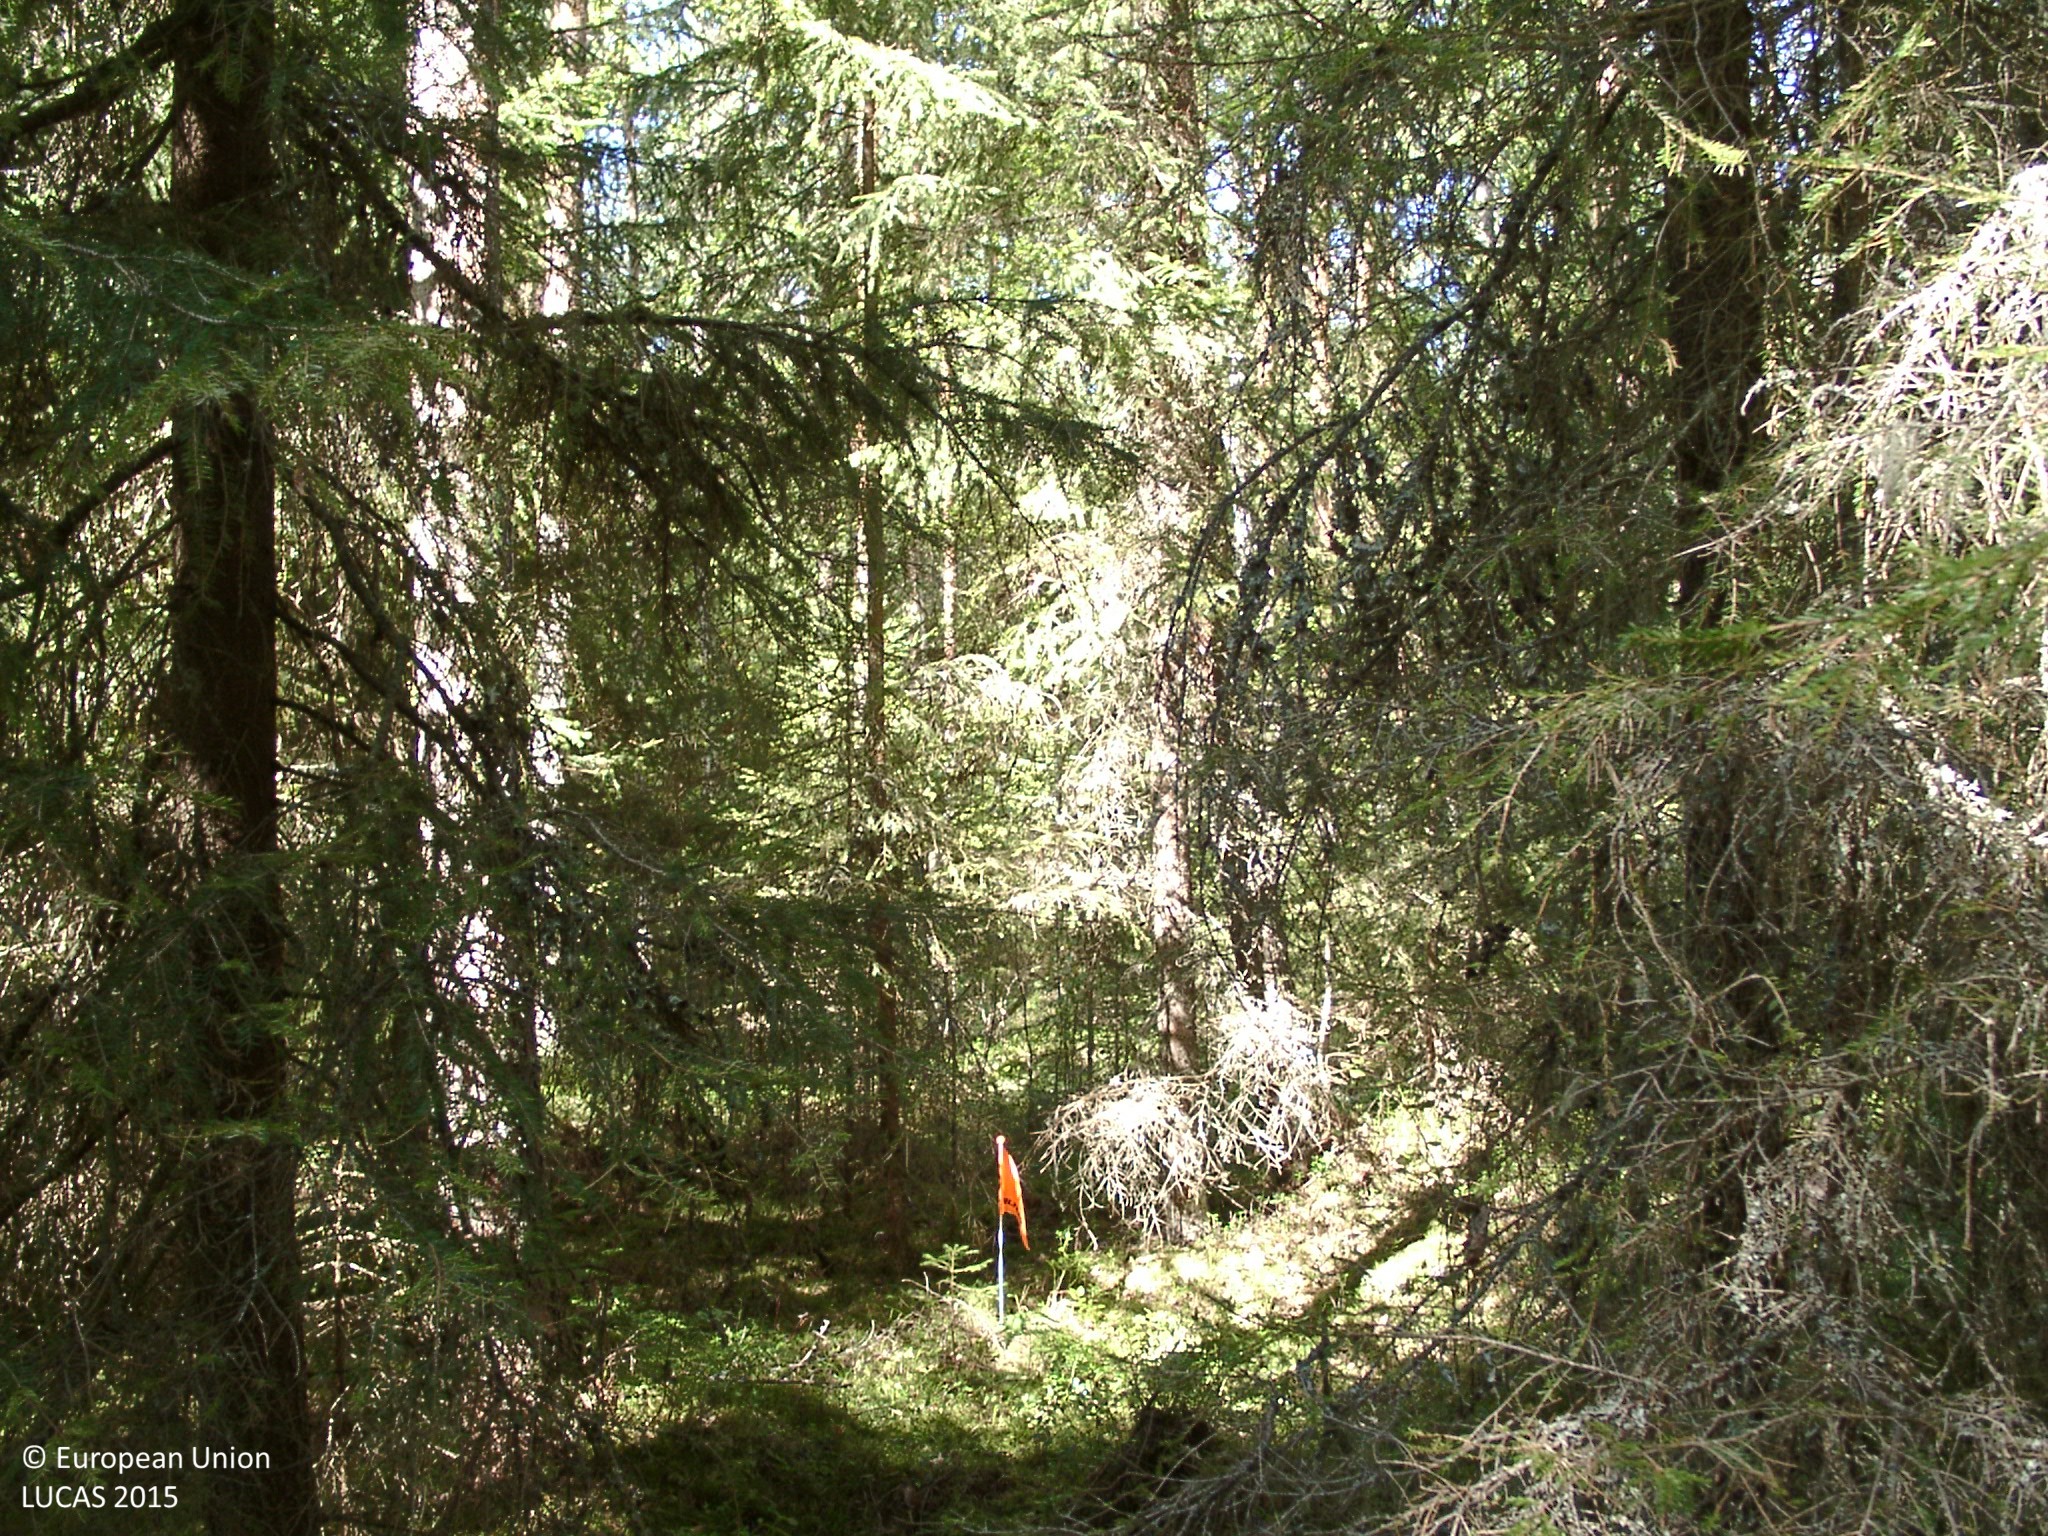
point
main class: Woodland
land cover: Other coniferous woodland
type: boreal forest
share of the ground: > 75 %
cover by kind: coniferous forest trees 65 %, broadleaved forest trees 20 %, shrubs 10 %, lichens and mosses 5 %
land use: Forestry
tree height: > 5 m
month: August
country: FI
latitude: 61.9300
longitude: 24.9834
